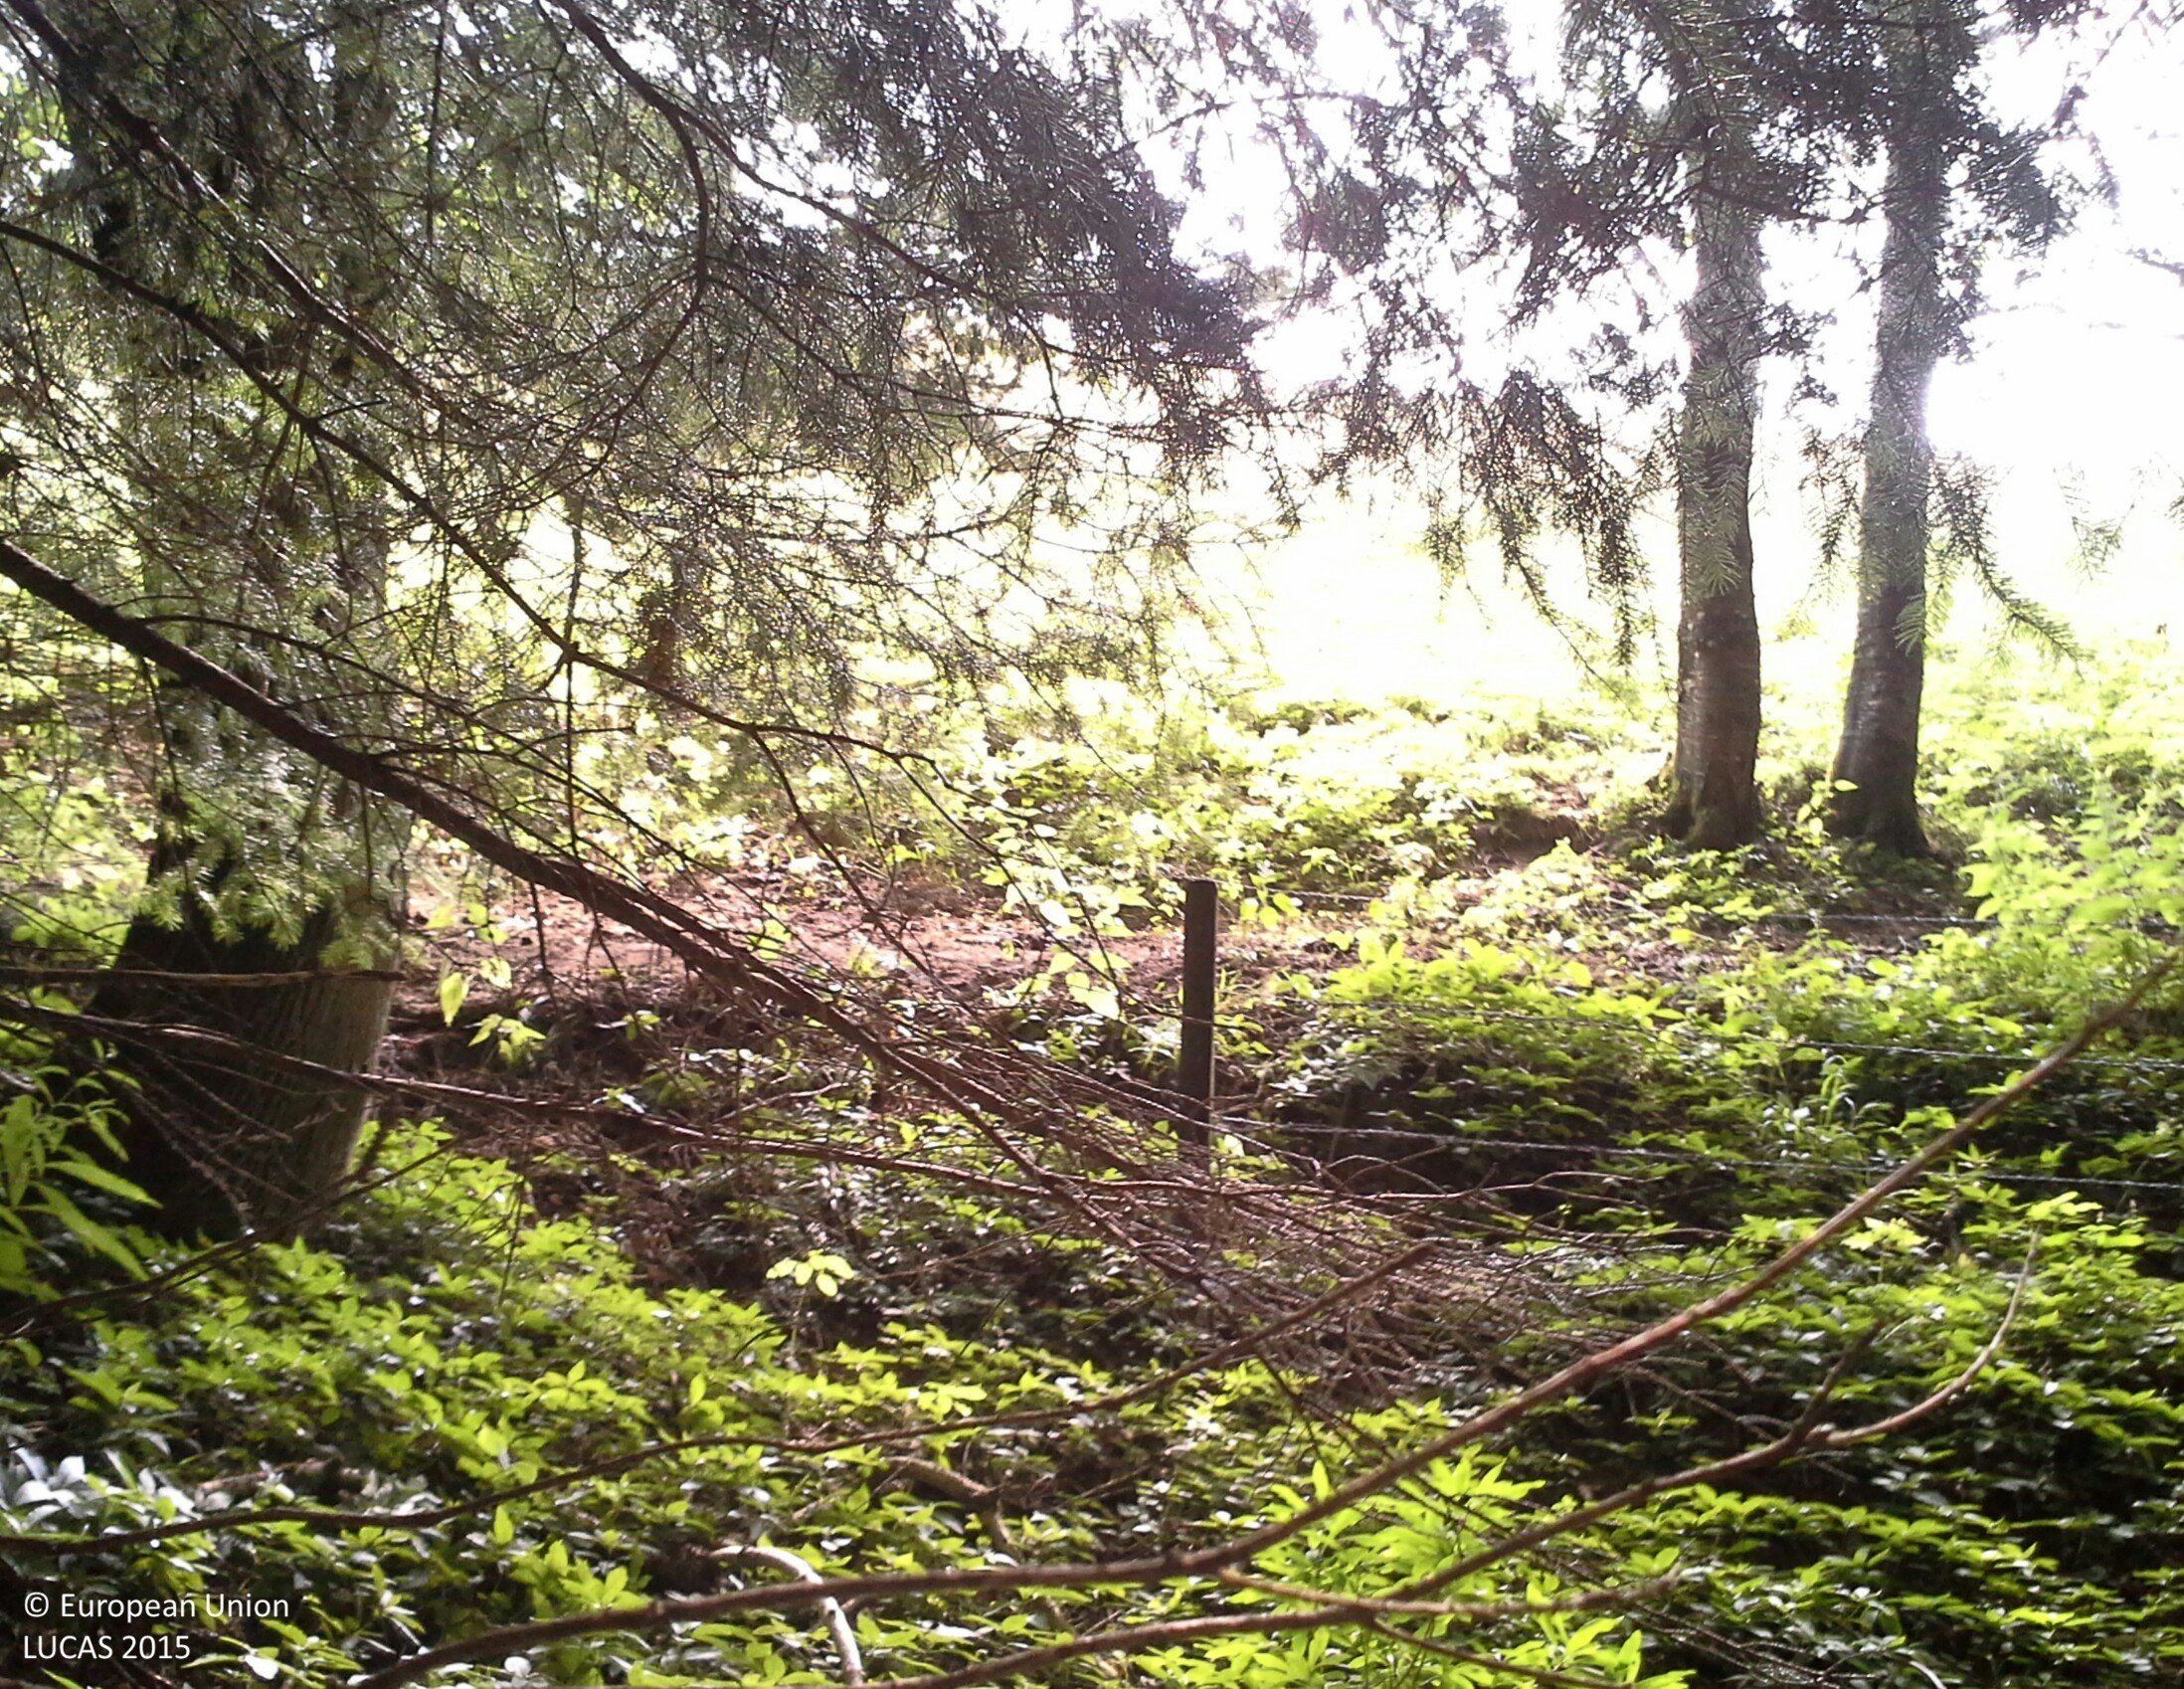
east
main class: Woodland
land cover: Spruce dominated mixed woodland
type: beech forest
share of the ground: > 75 %
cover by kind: coniferous forest trees 70 %, broadleaved forest trees 25 %, herbaceous plants 5 %
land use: Forestry
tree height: > 5 m
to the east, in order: Spruce dominated mixed woodland; Fences; Spruce dominated mixed woodland; Grassland without tree/shrub cover; Grassland with sparse tree/shrub cover; Grassland without tree/shrub cover; Fences; Grassland without tree/shrub cover
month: July
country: AT
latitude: 47.9847
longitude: 14.5690
